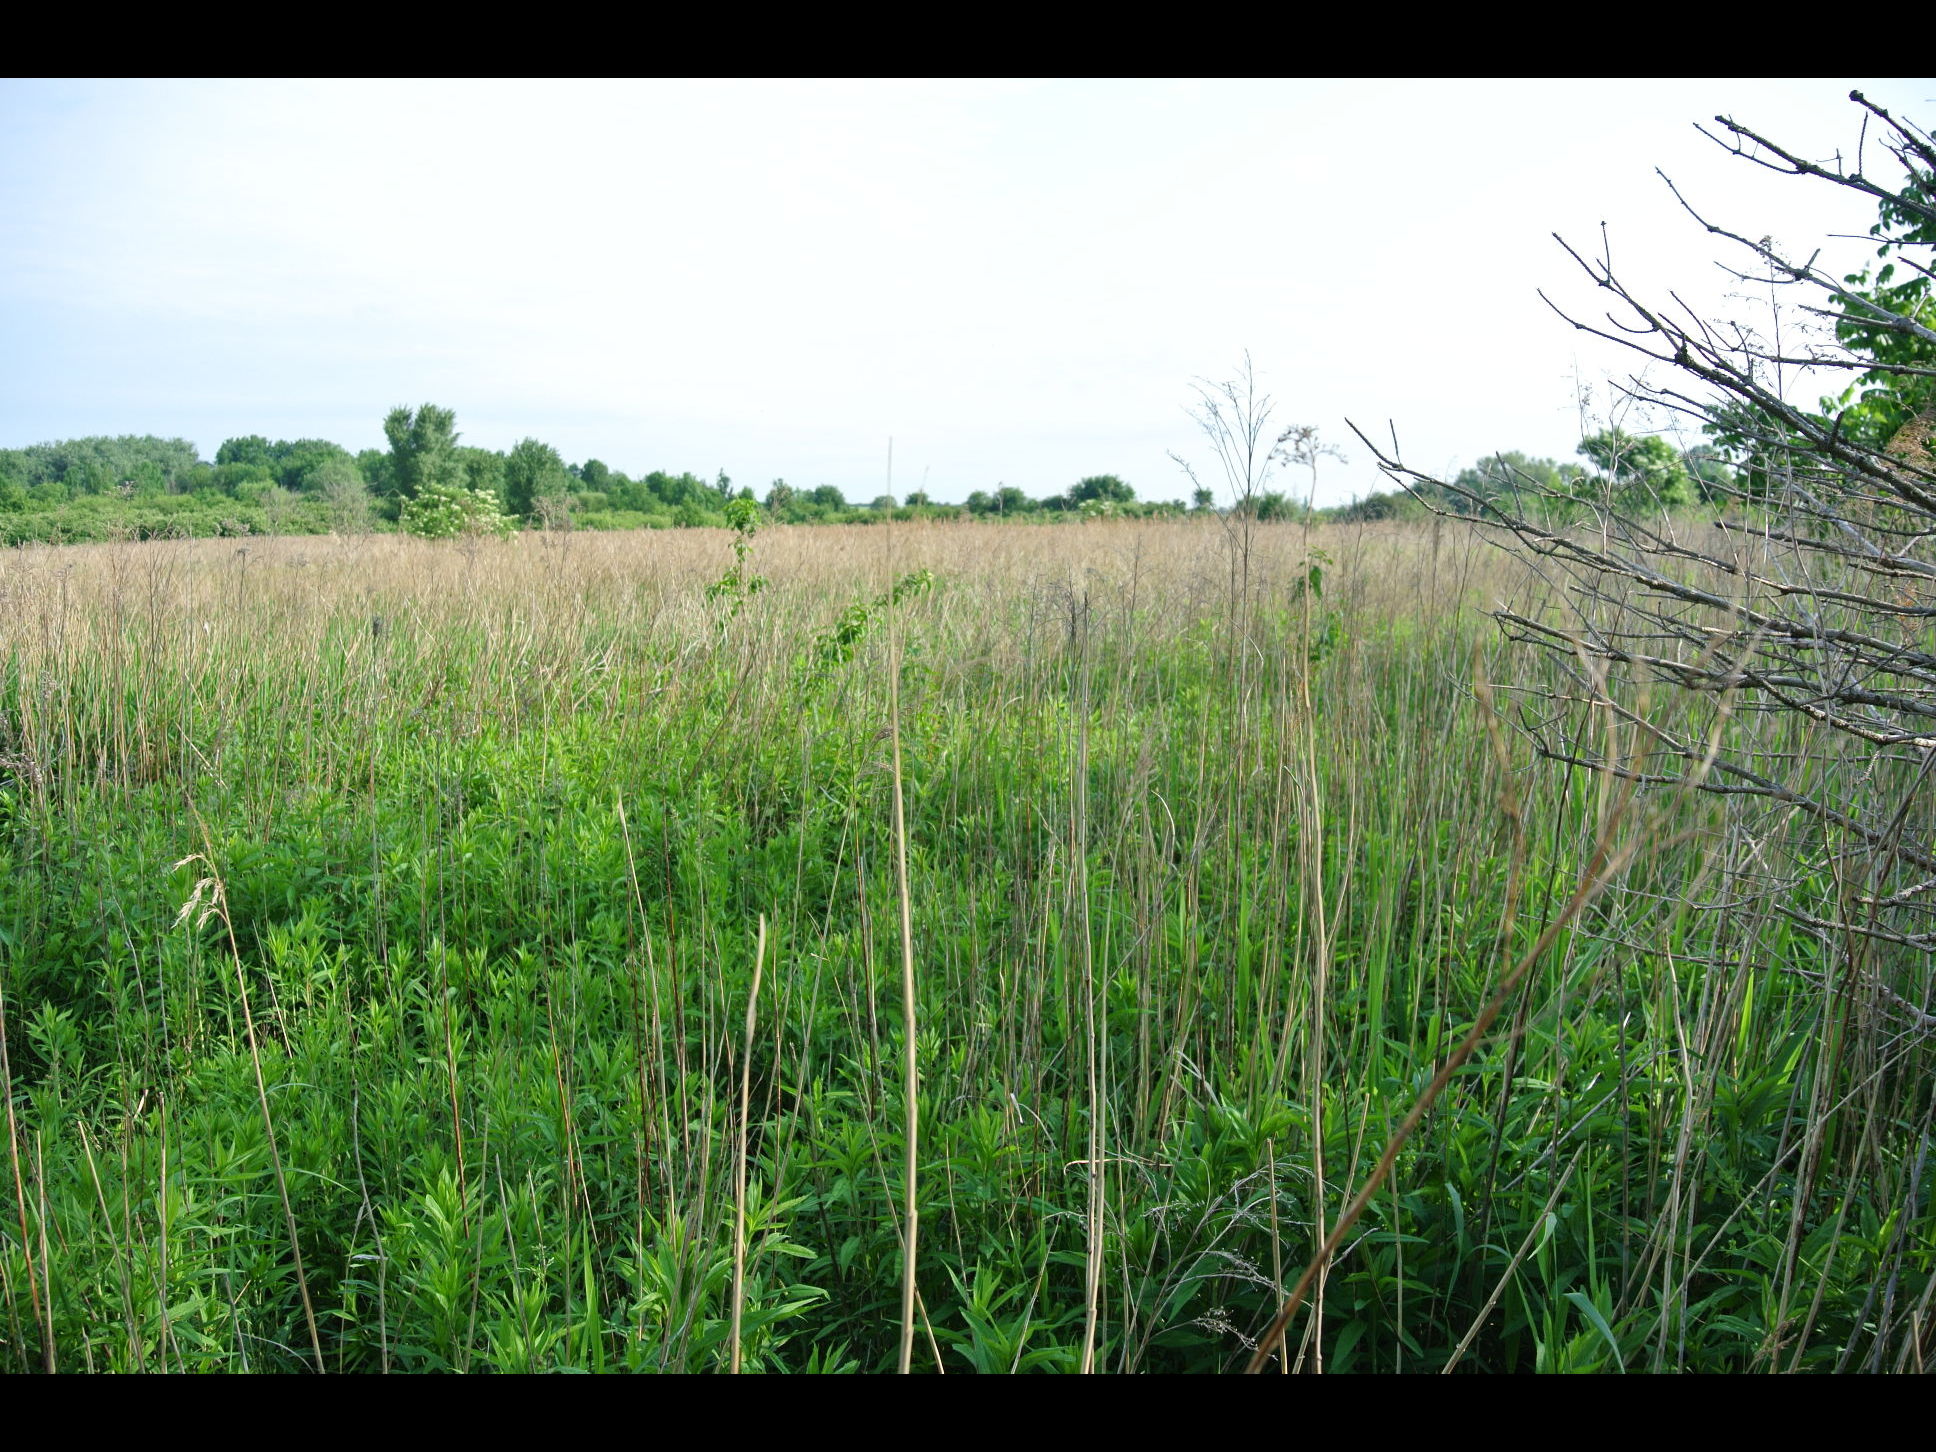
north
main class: Shrubland
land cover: Shrubland with sparse tree cover
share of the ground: 50 - 75 %
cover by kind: shrubs 65 %, herbaceous plants 30 %, broadleaved forest trees 5 %
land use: Semi-natural and natural areas not in use
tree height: > 5 m
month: May
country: AT
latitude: 48.0638
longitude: 16.5674
